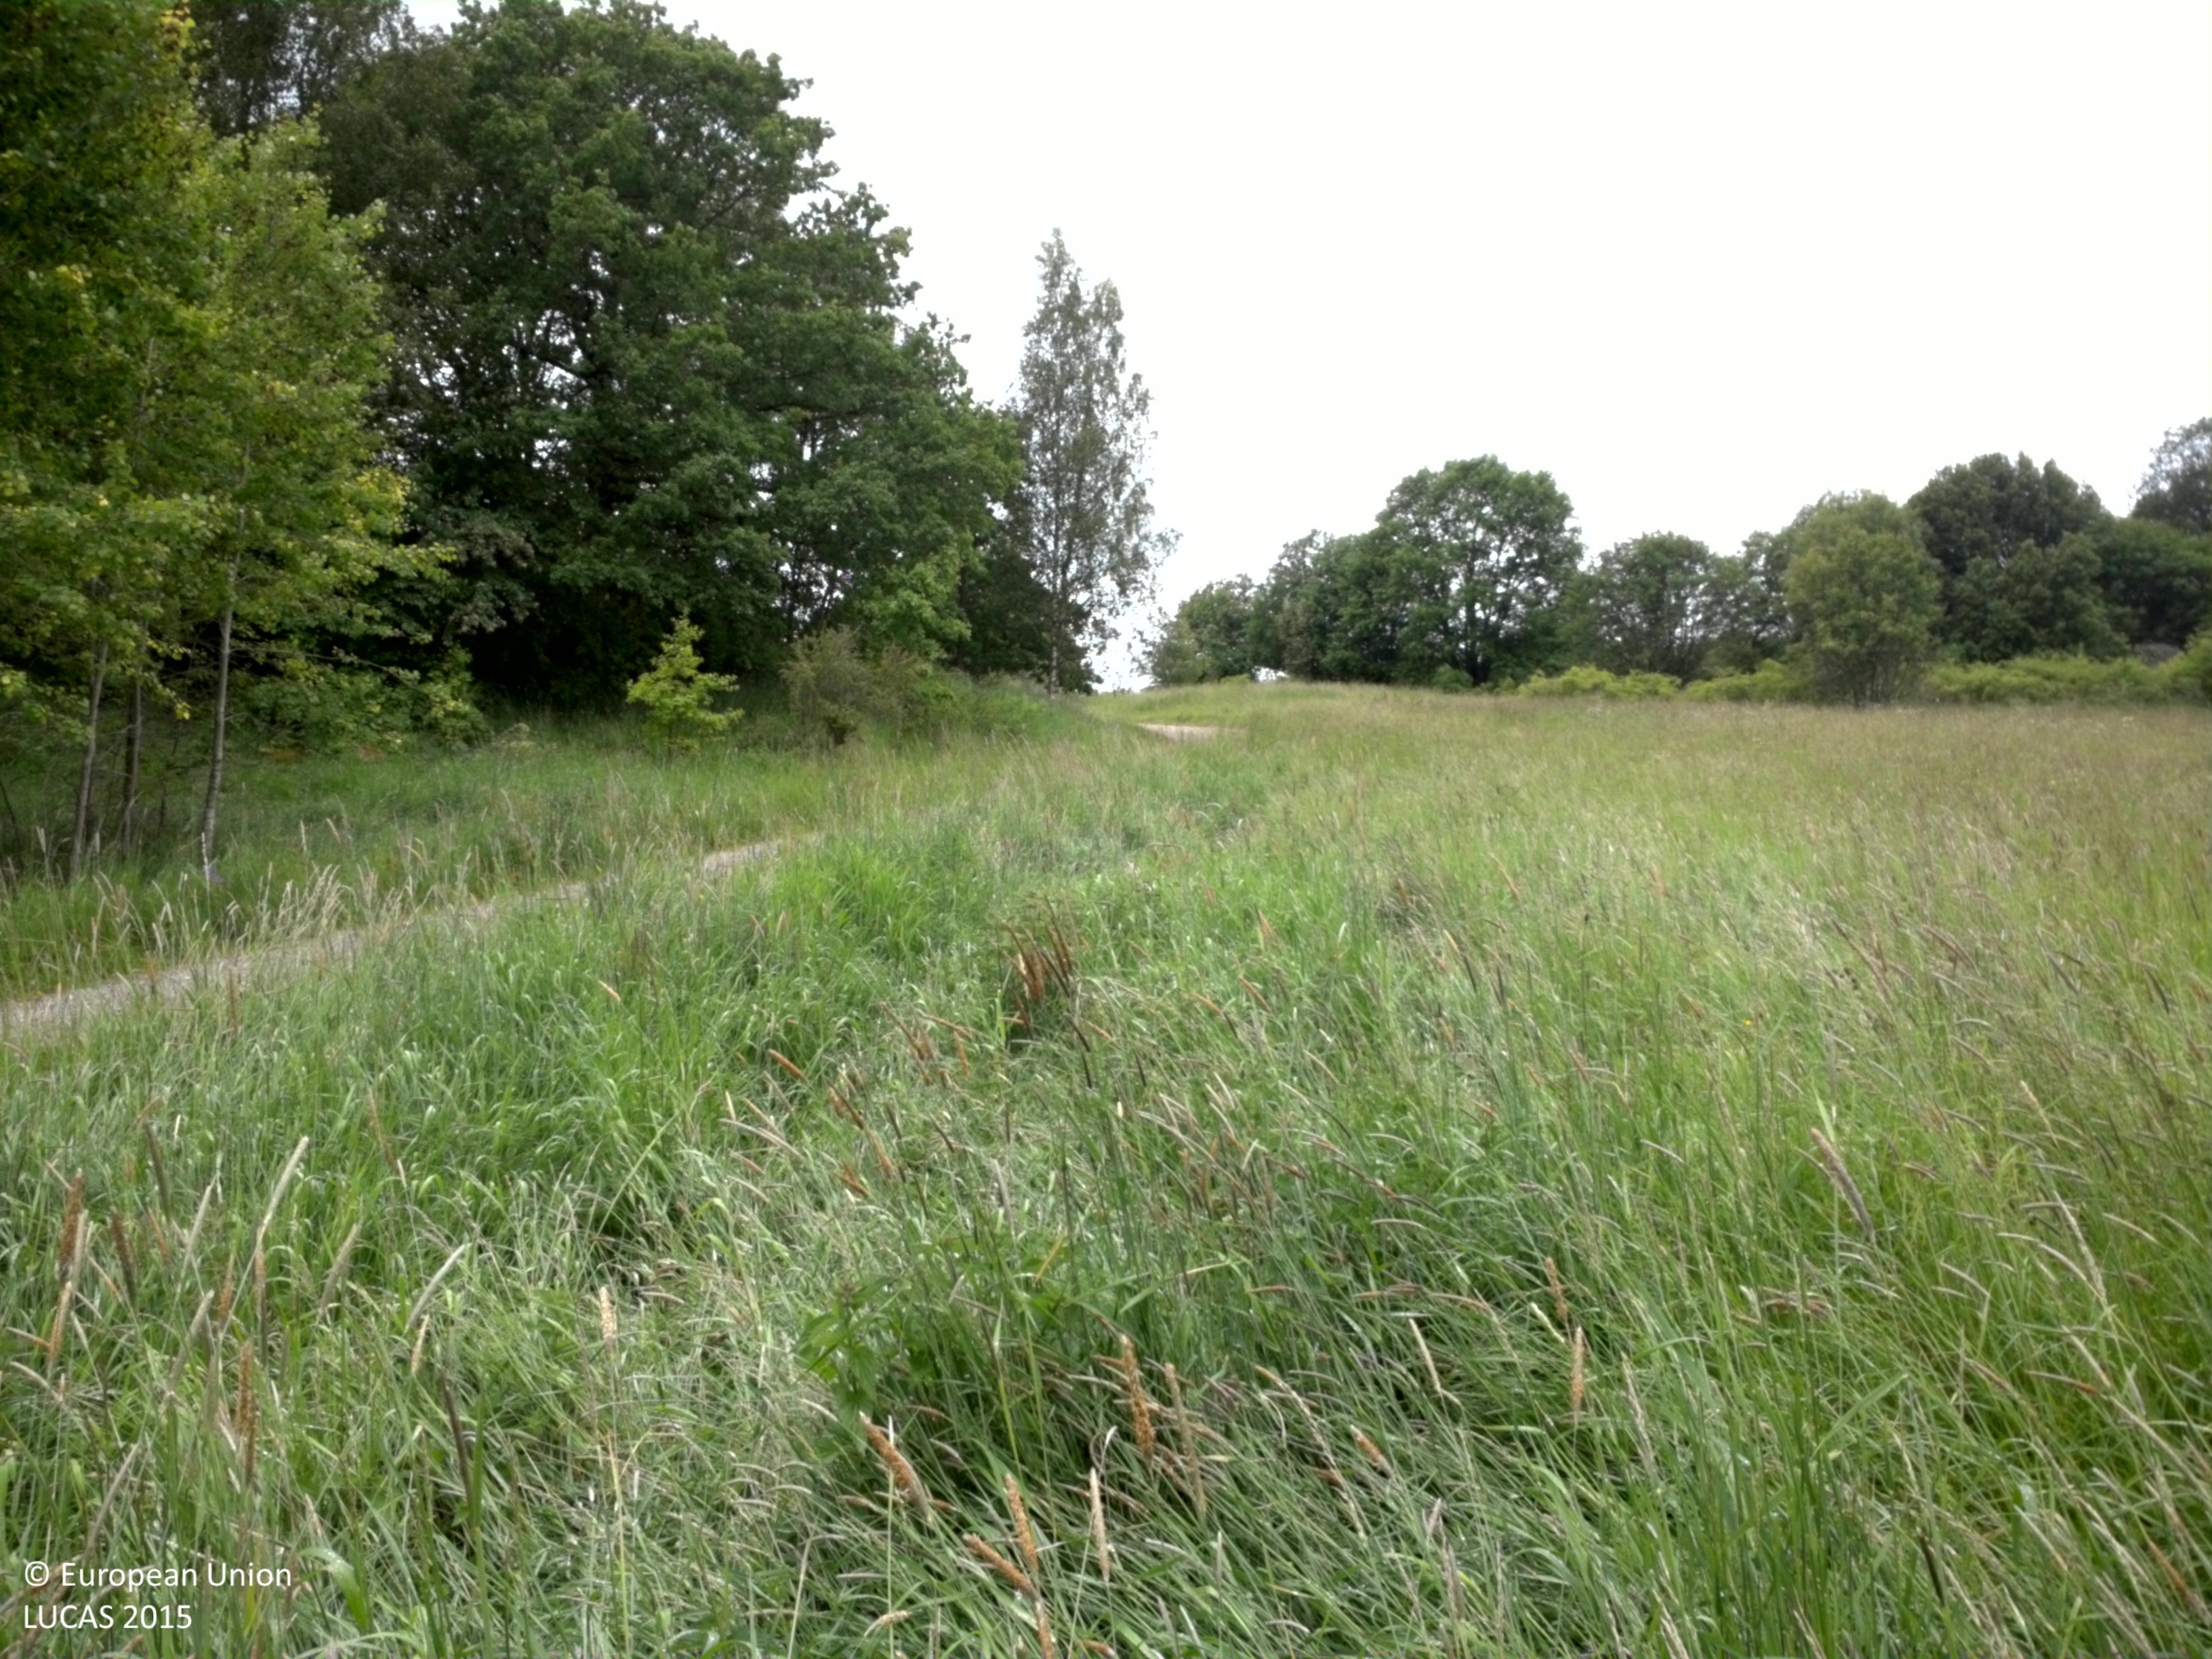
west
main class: Cropland
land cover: Other leguminous and mixtures for fodder
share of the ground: > 75 %
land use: Agriculture (excluding fallow land and kitchen gardens)
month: June
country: SE
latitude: 59.7306
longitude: 18.6973
